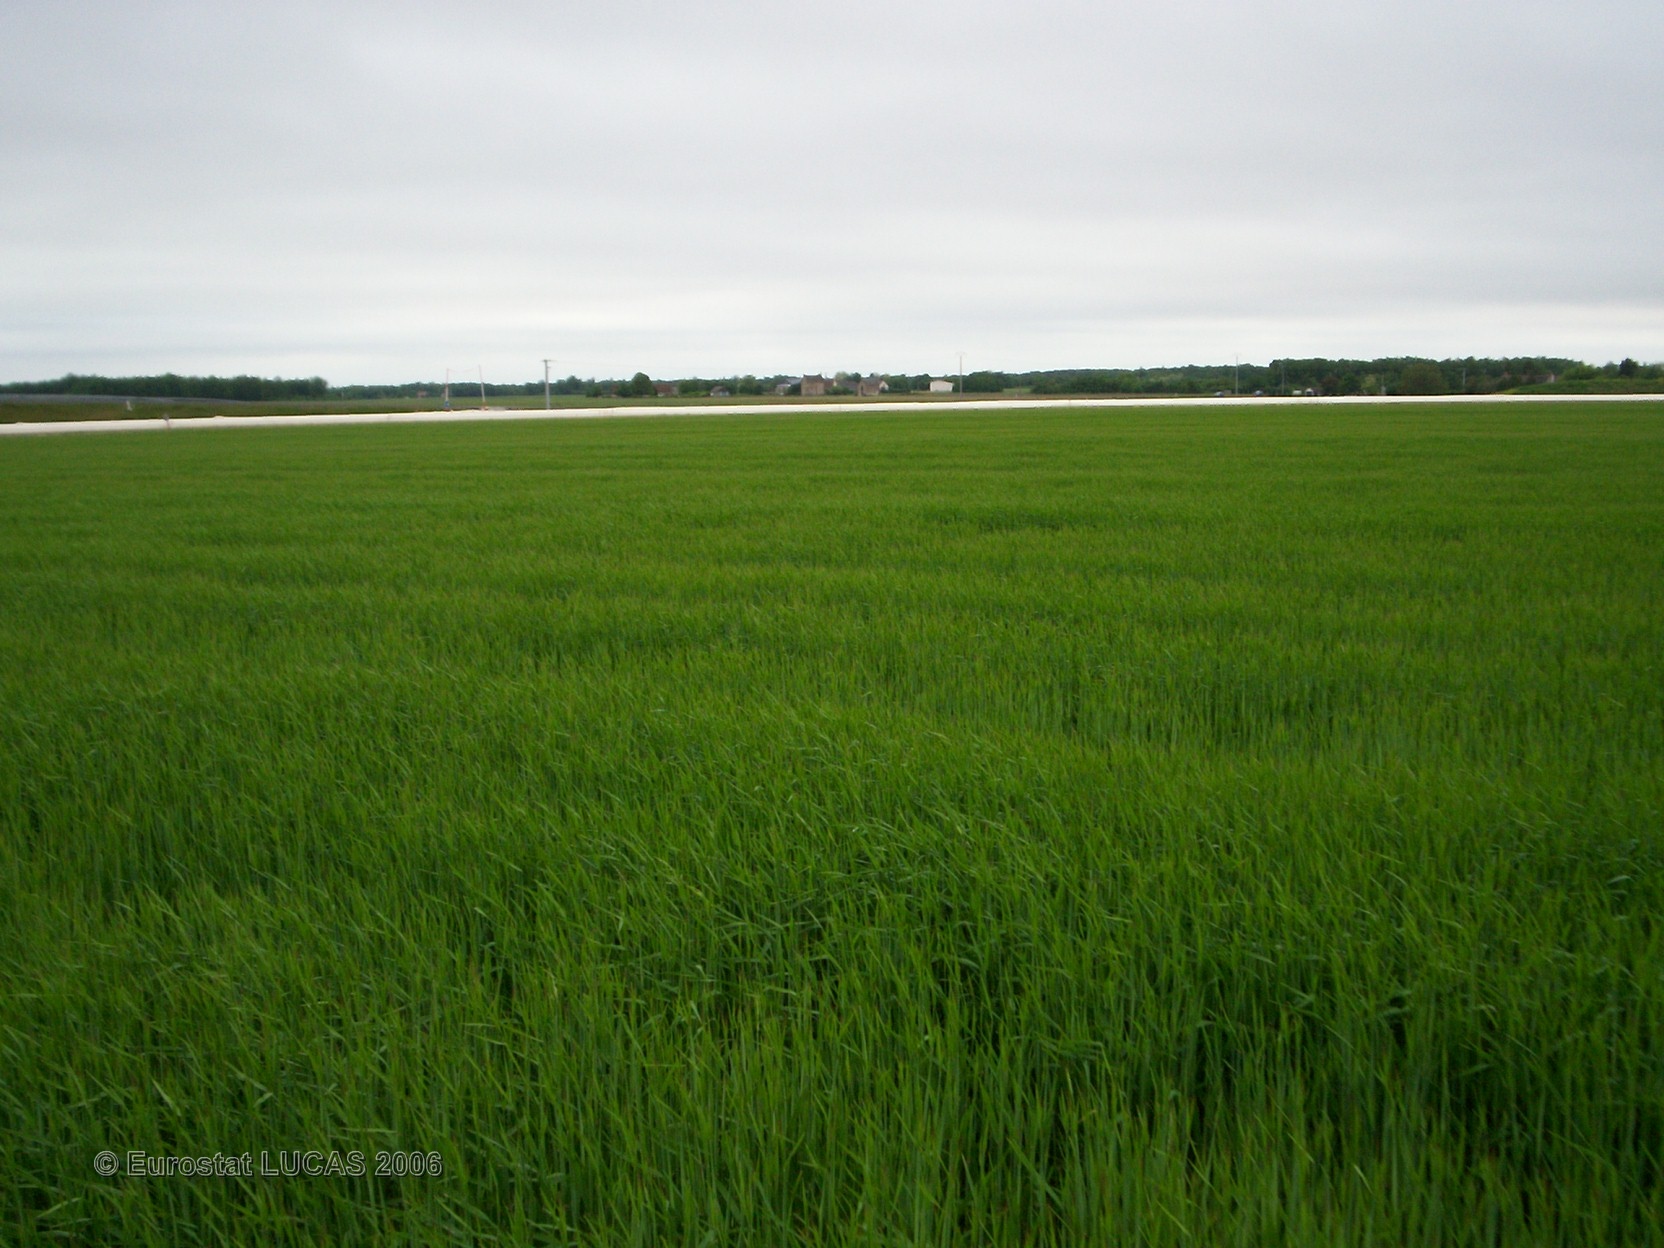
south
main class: Cropland
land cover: Triticale
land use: Agriculture (excluding fallow land and kitchen gardens)
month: May
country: FR
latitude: 47.3029
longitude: 0.8963
